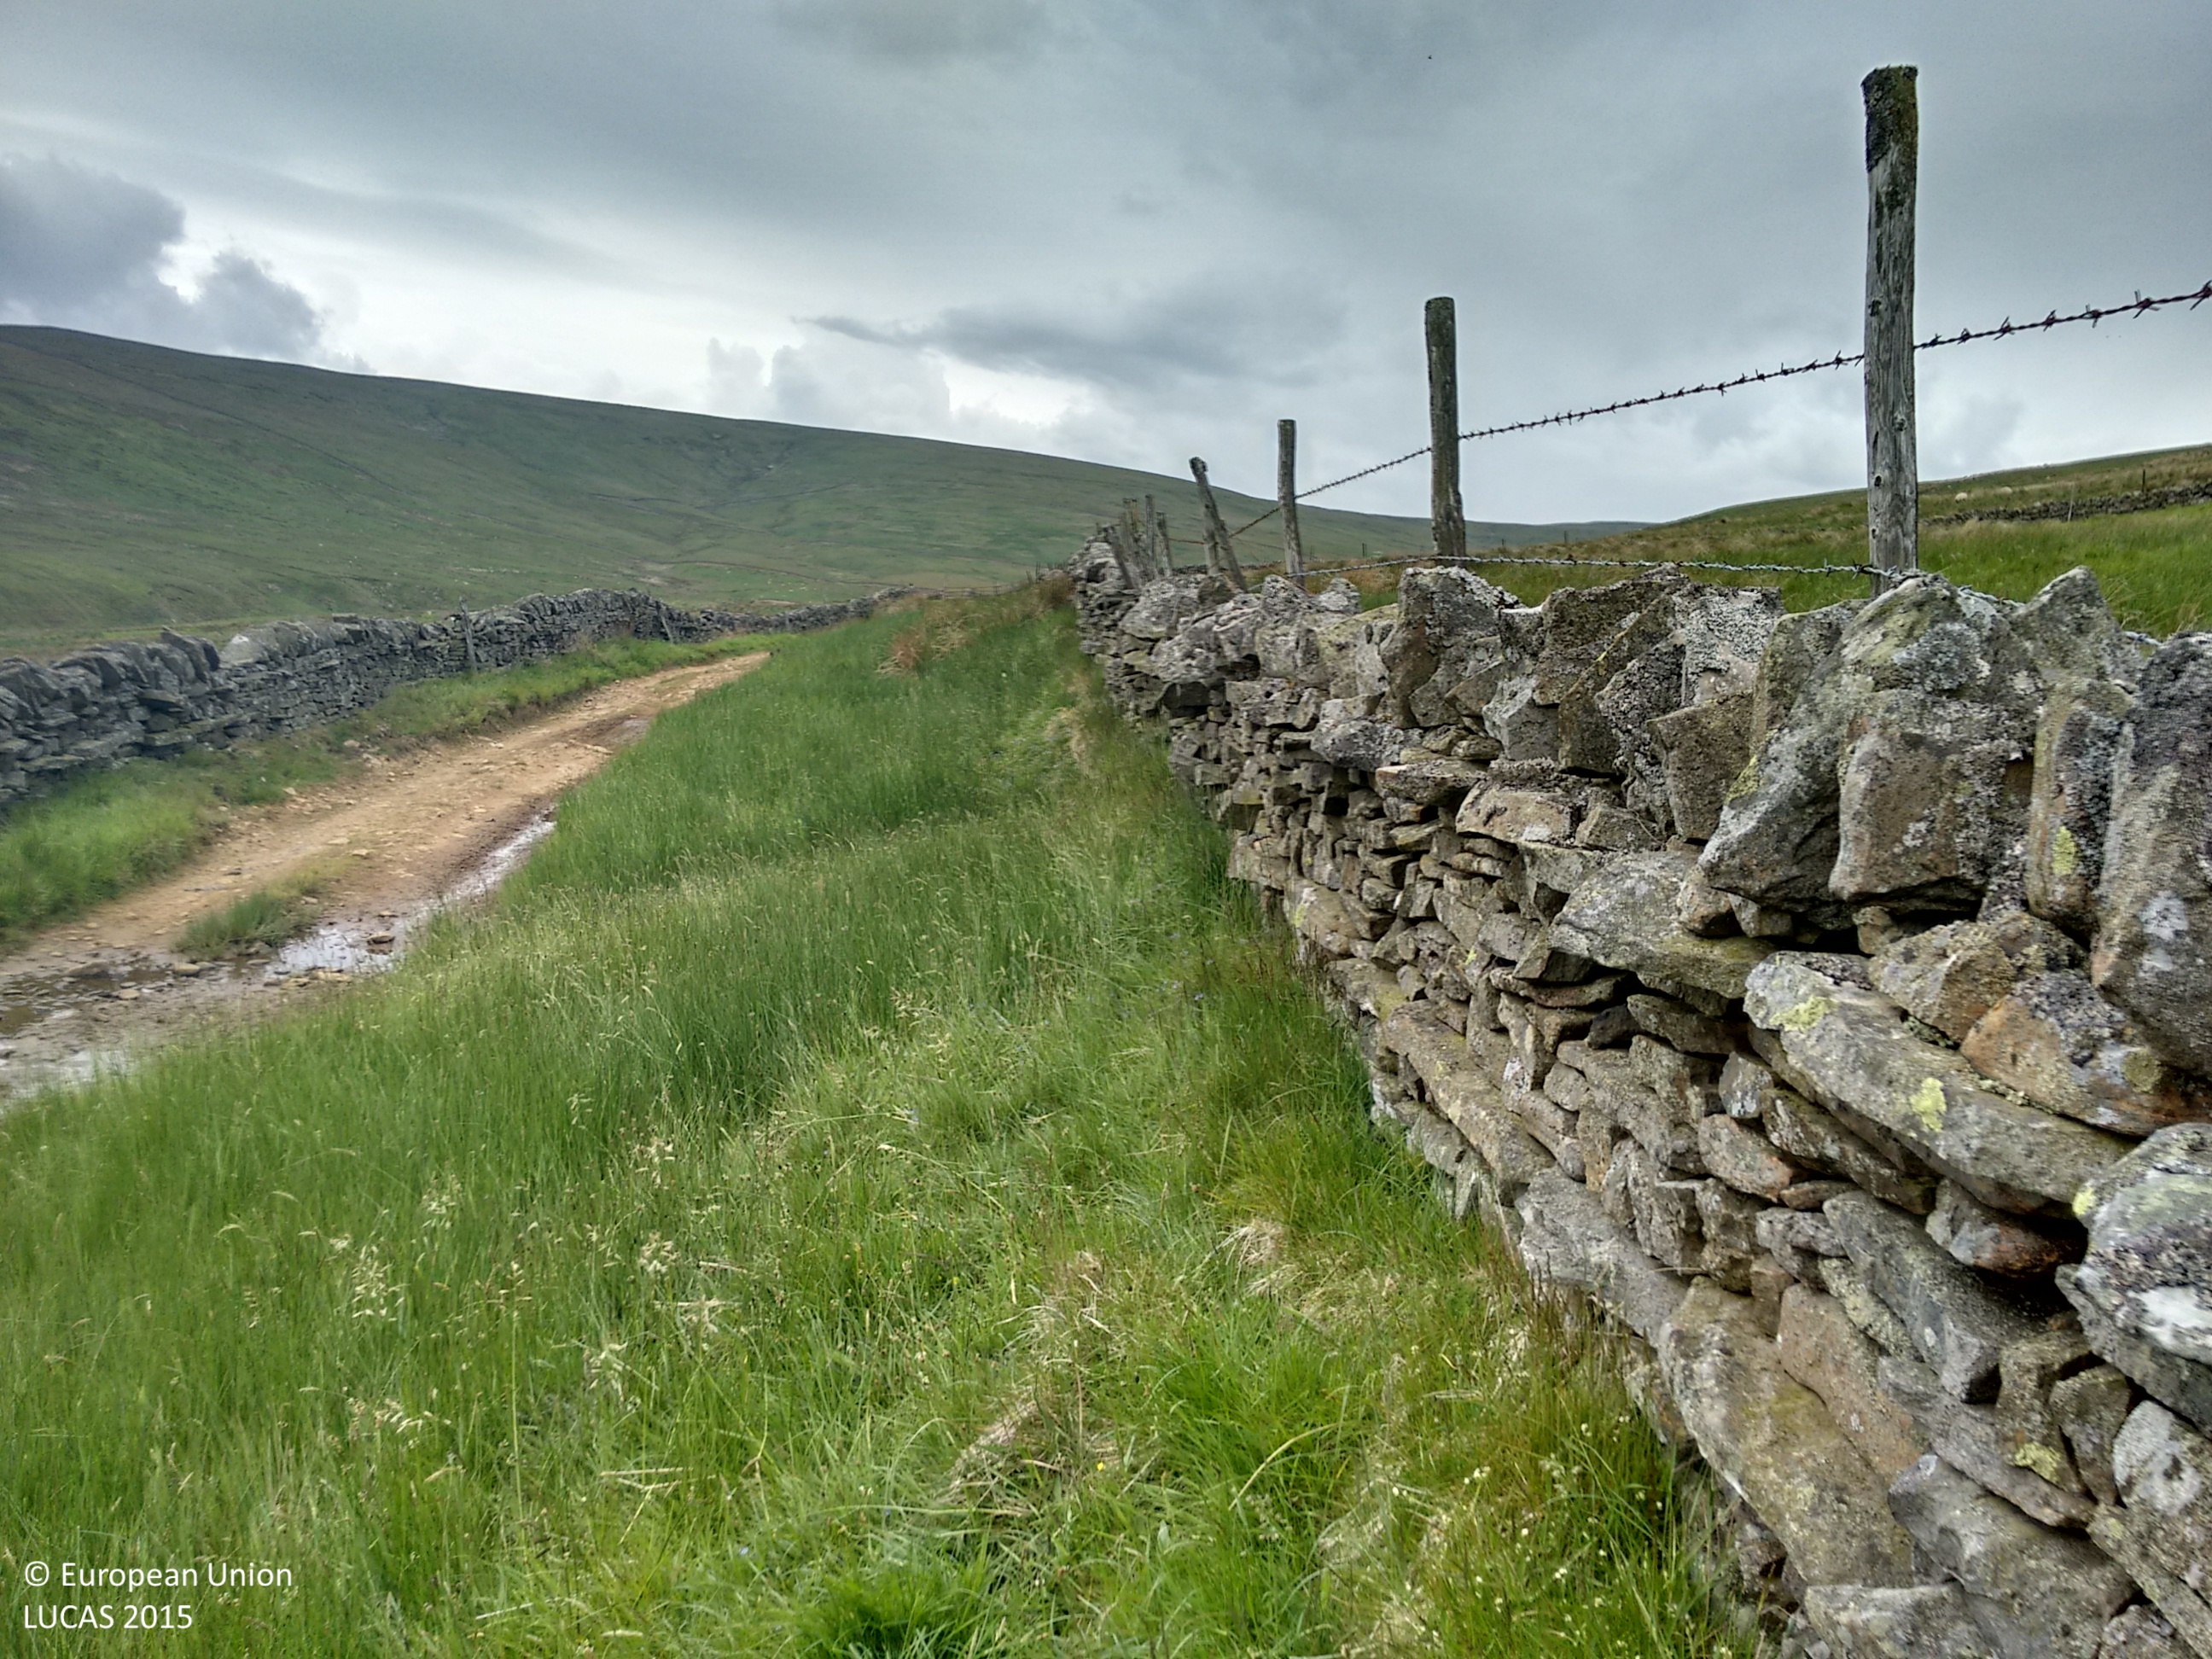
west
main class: Grassland
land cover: Grassland without tree/shrub cover
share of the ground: > 75 %
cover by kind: herbaceous plants 100 %
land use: Agriculture (excluding fallow land and kitchen gardens)
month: June
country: GB
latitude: 54.7689
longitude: -2.1663
